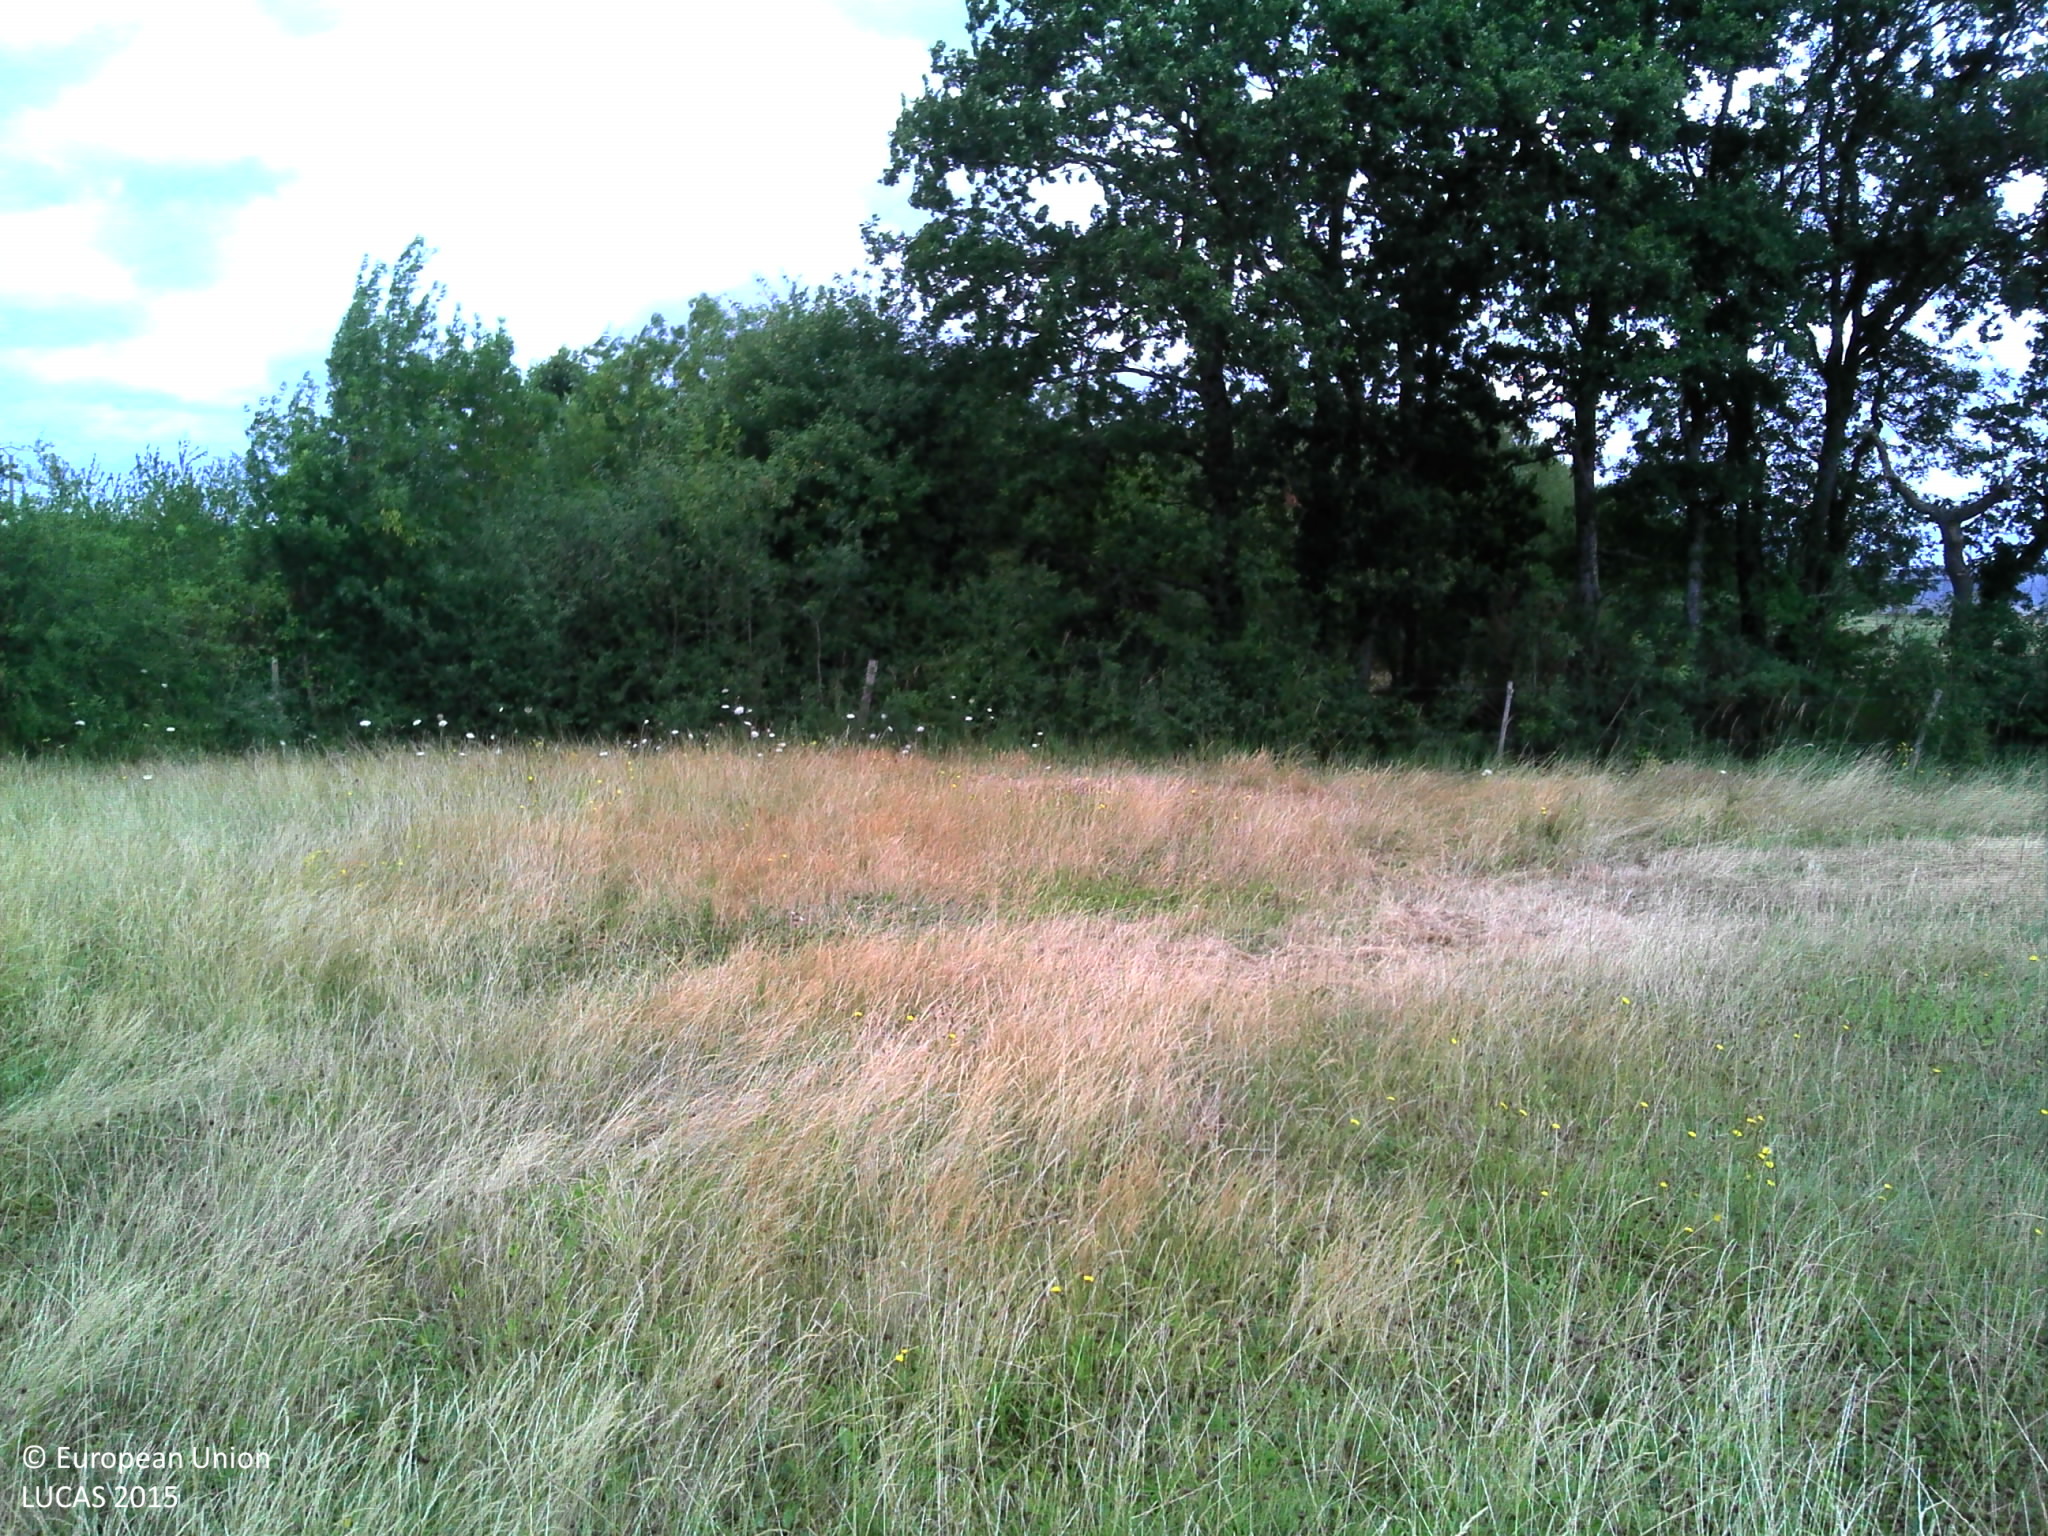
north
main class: Cropland
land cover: Temporary grasslands
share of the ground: > 75 %
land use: Agriculture (excluding fallow land and kitchen gardens)
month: July
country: FR
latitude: 47.4500
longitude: -1.8914
